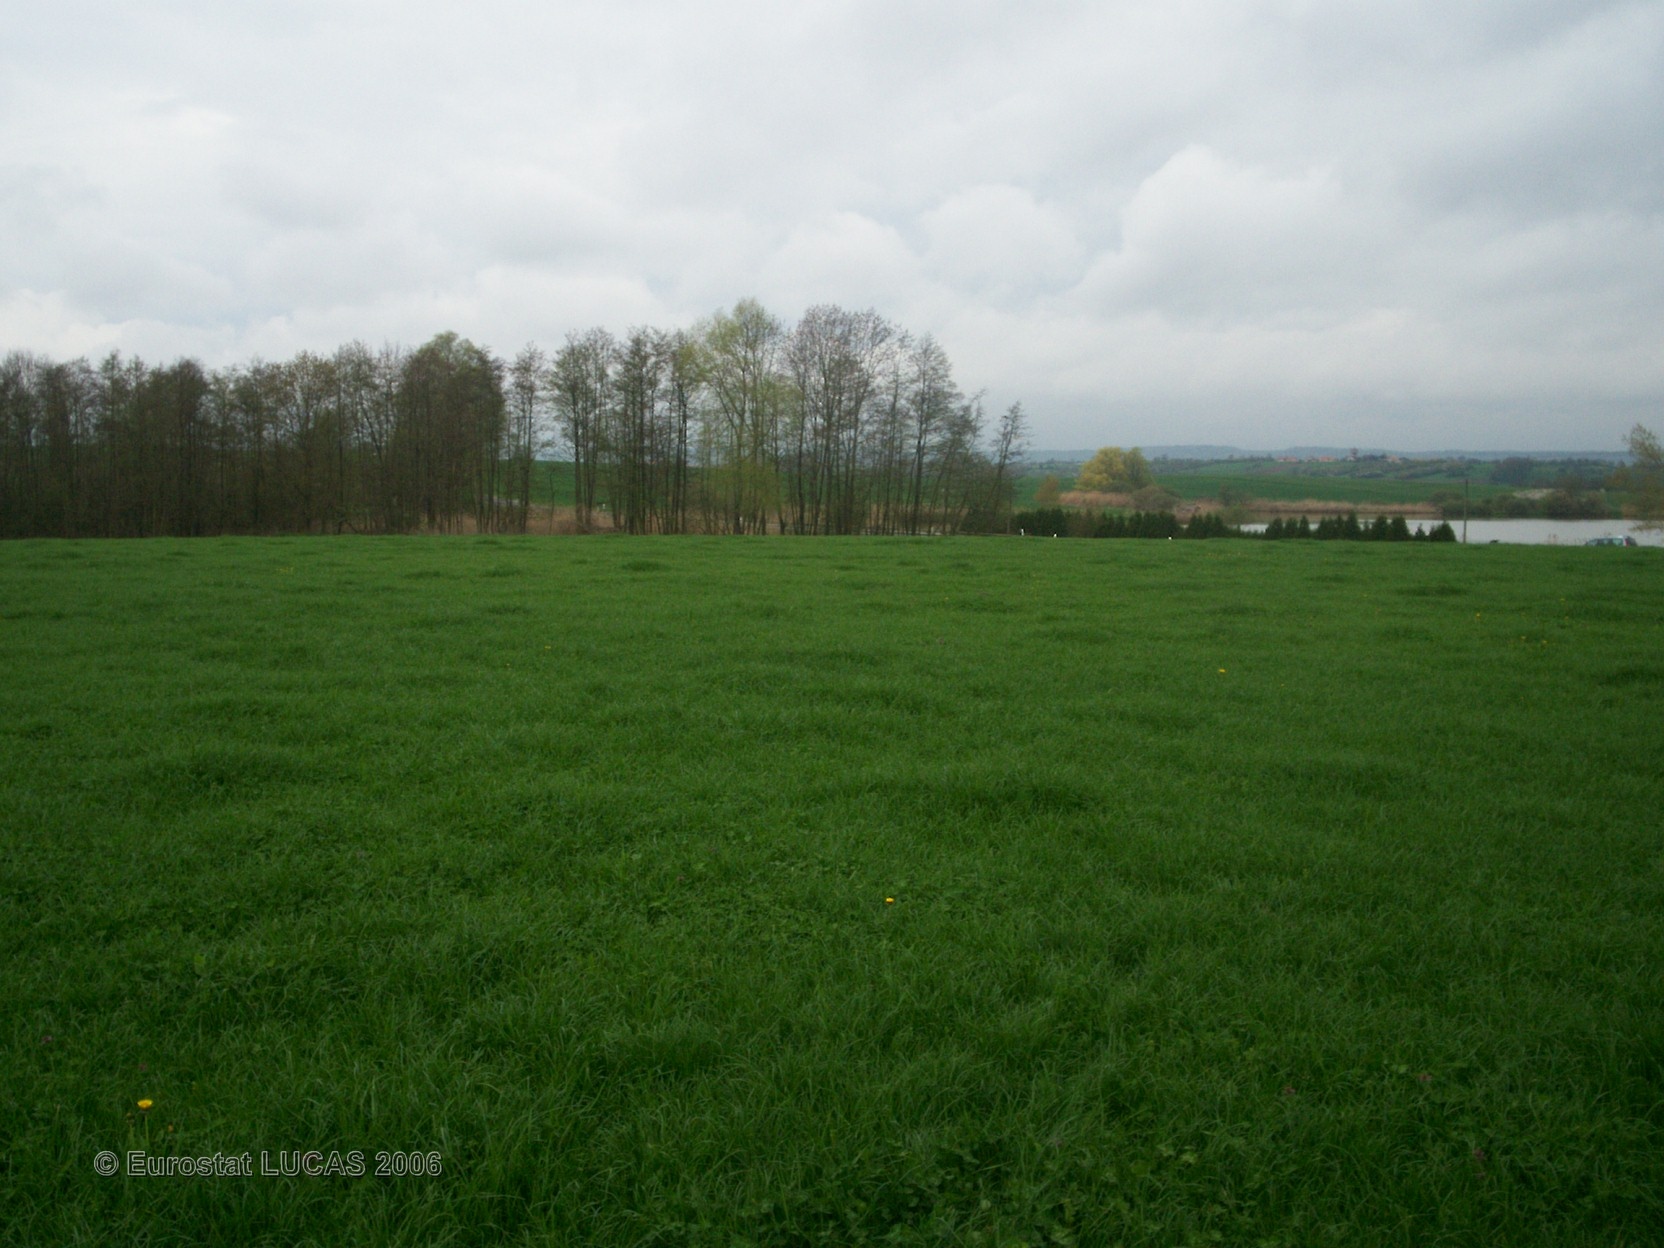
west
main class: Grassland
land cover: Grassland without tree/shrub cover
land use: Agriculture (excluding fallow land and kitchen gardens)
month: April
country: FR
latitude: 48.8246
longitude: 6.7722
